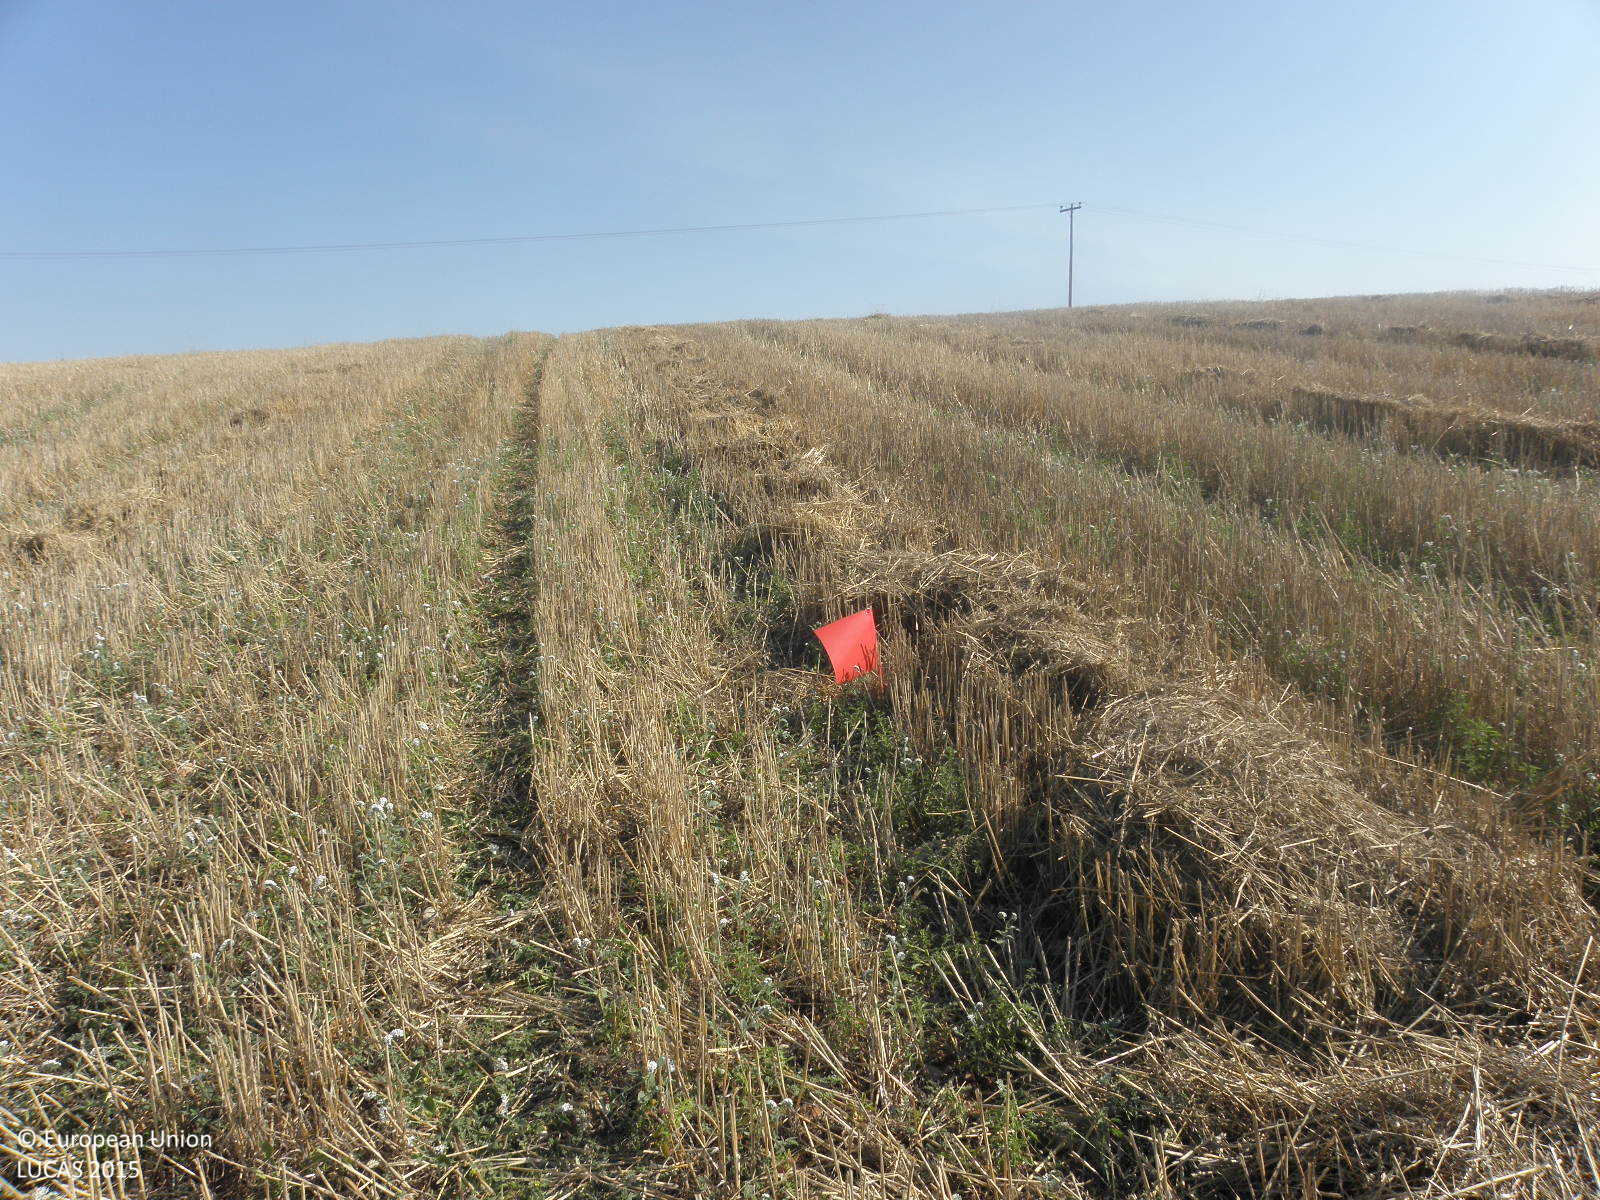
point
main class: Cropland
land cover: Durum wheat
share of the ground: > 75 %
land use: Agriculture (excluding fallow land and kitchen gardens)
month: July
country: GR
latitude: 39.4366
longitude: 22.2901
